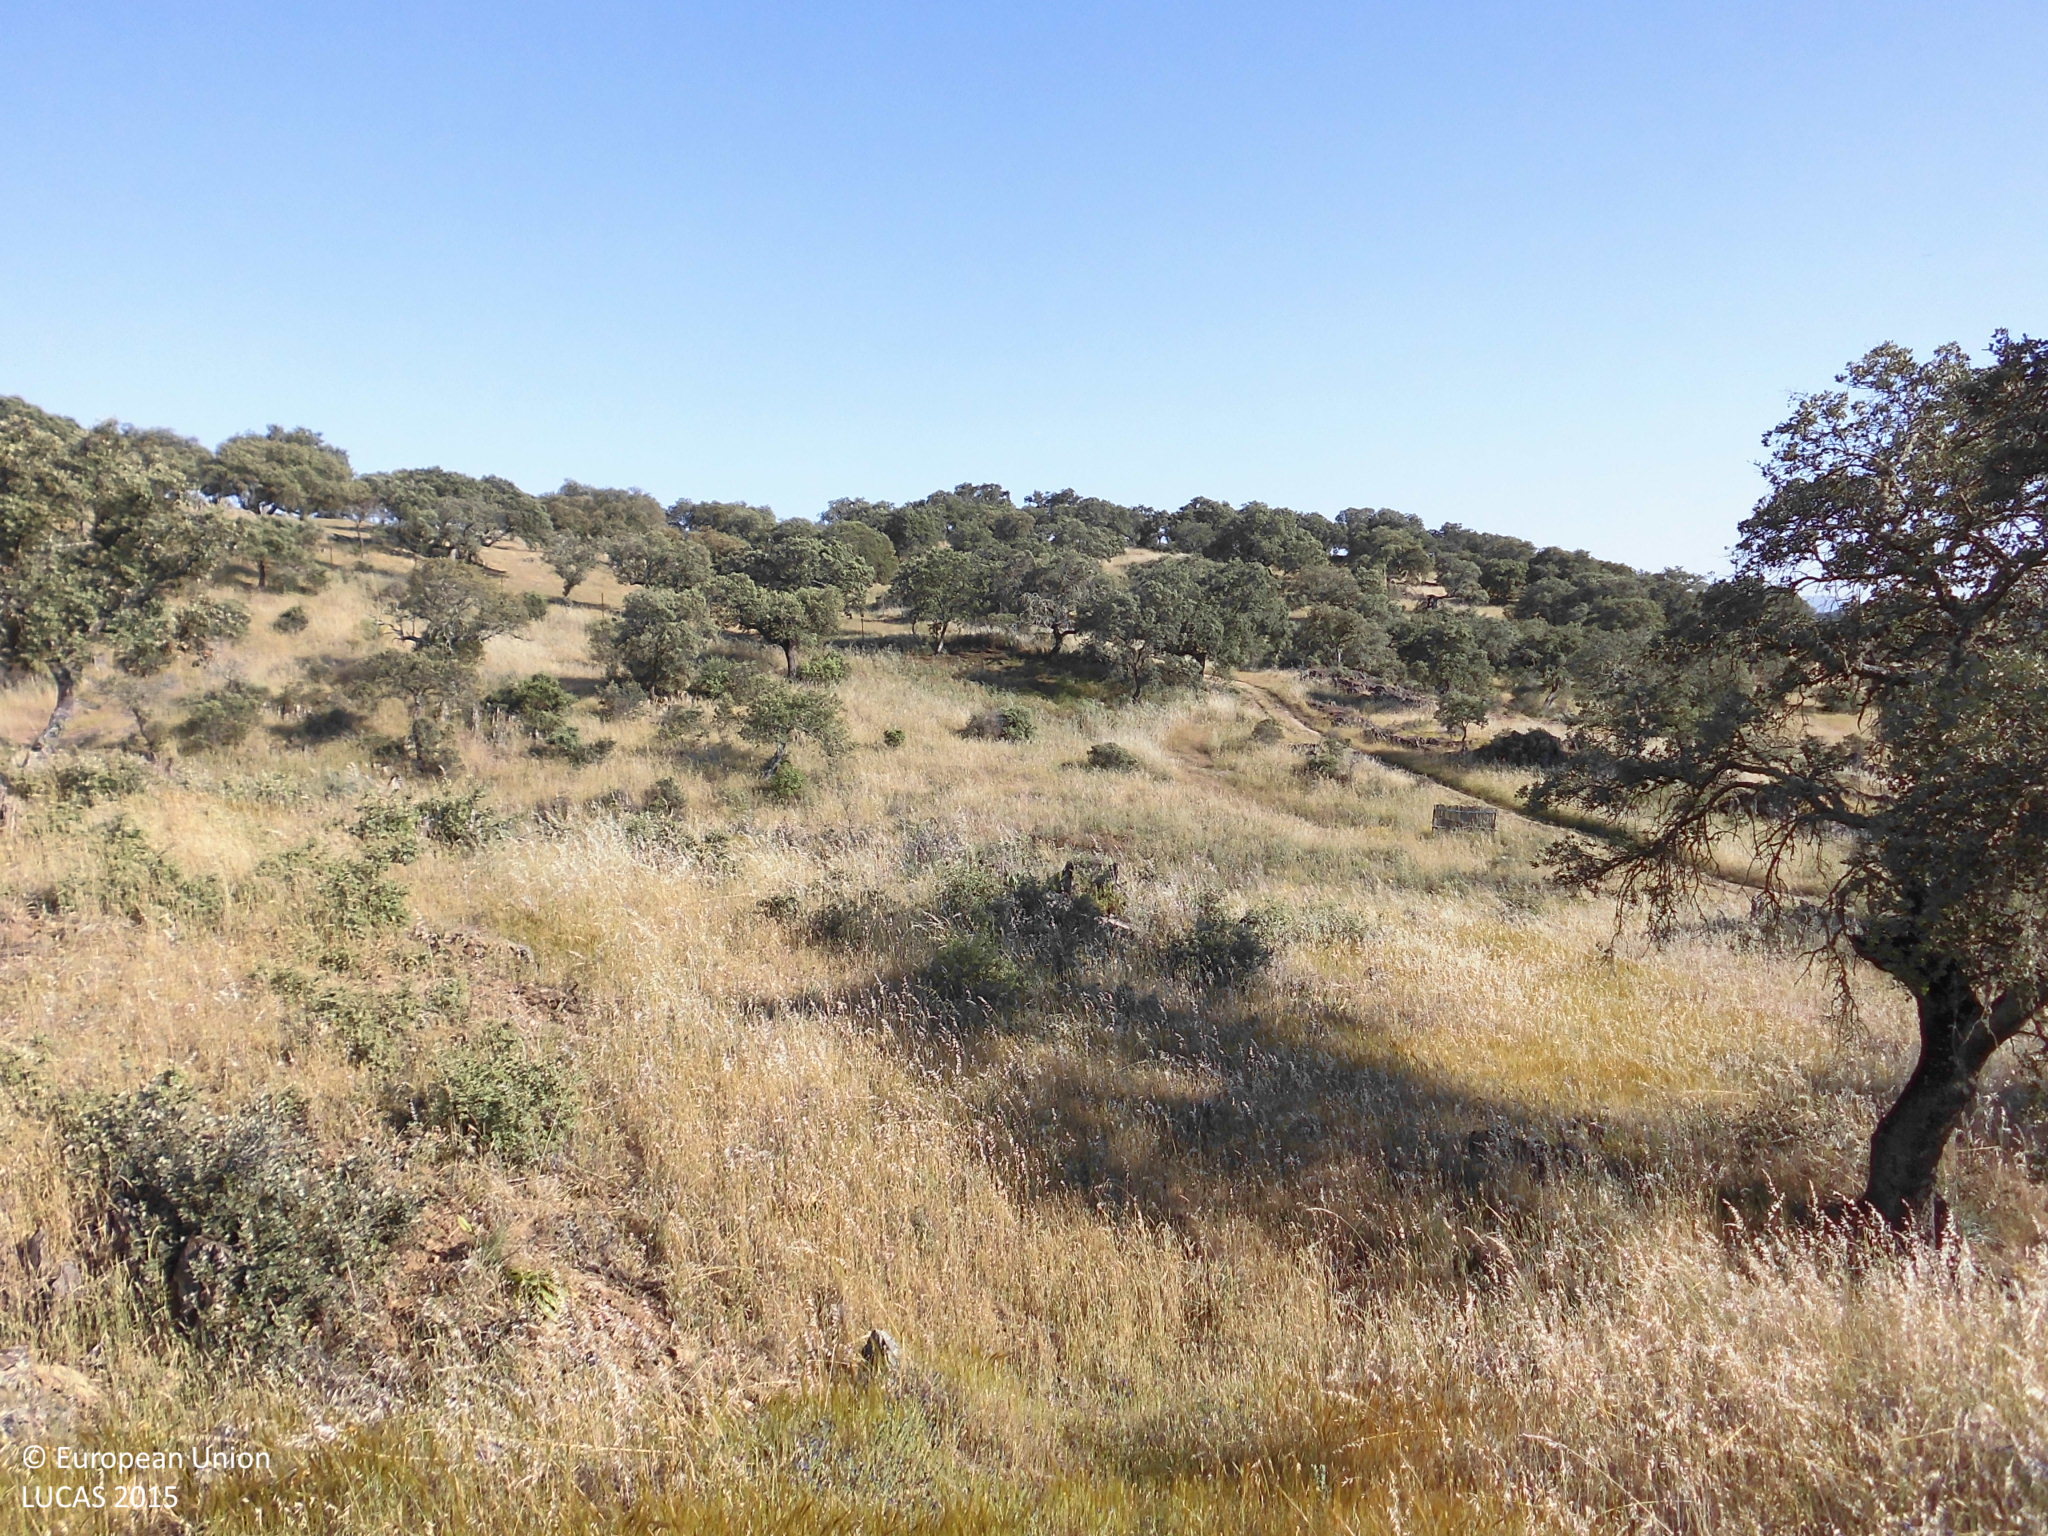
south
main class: Woodland
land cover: Broadleaved woodland
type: broadleaved evergreen forest
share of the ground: 10 - 25 %
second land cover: Grassland without tree/shrub cover
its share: > 75 %
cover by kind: herbaceous plants 70 %, broadleaved forest trees 25 %, shrubs 5 %
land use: Forestry
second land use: Agriculture (excluding fallow land and kitchen gardens)
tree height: > 5 m
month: May
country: ES
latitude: 39.4986
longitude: -6.0989
